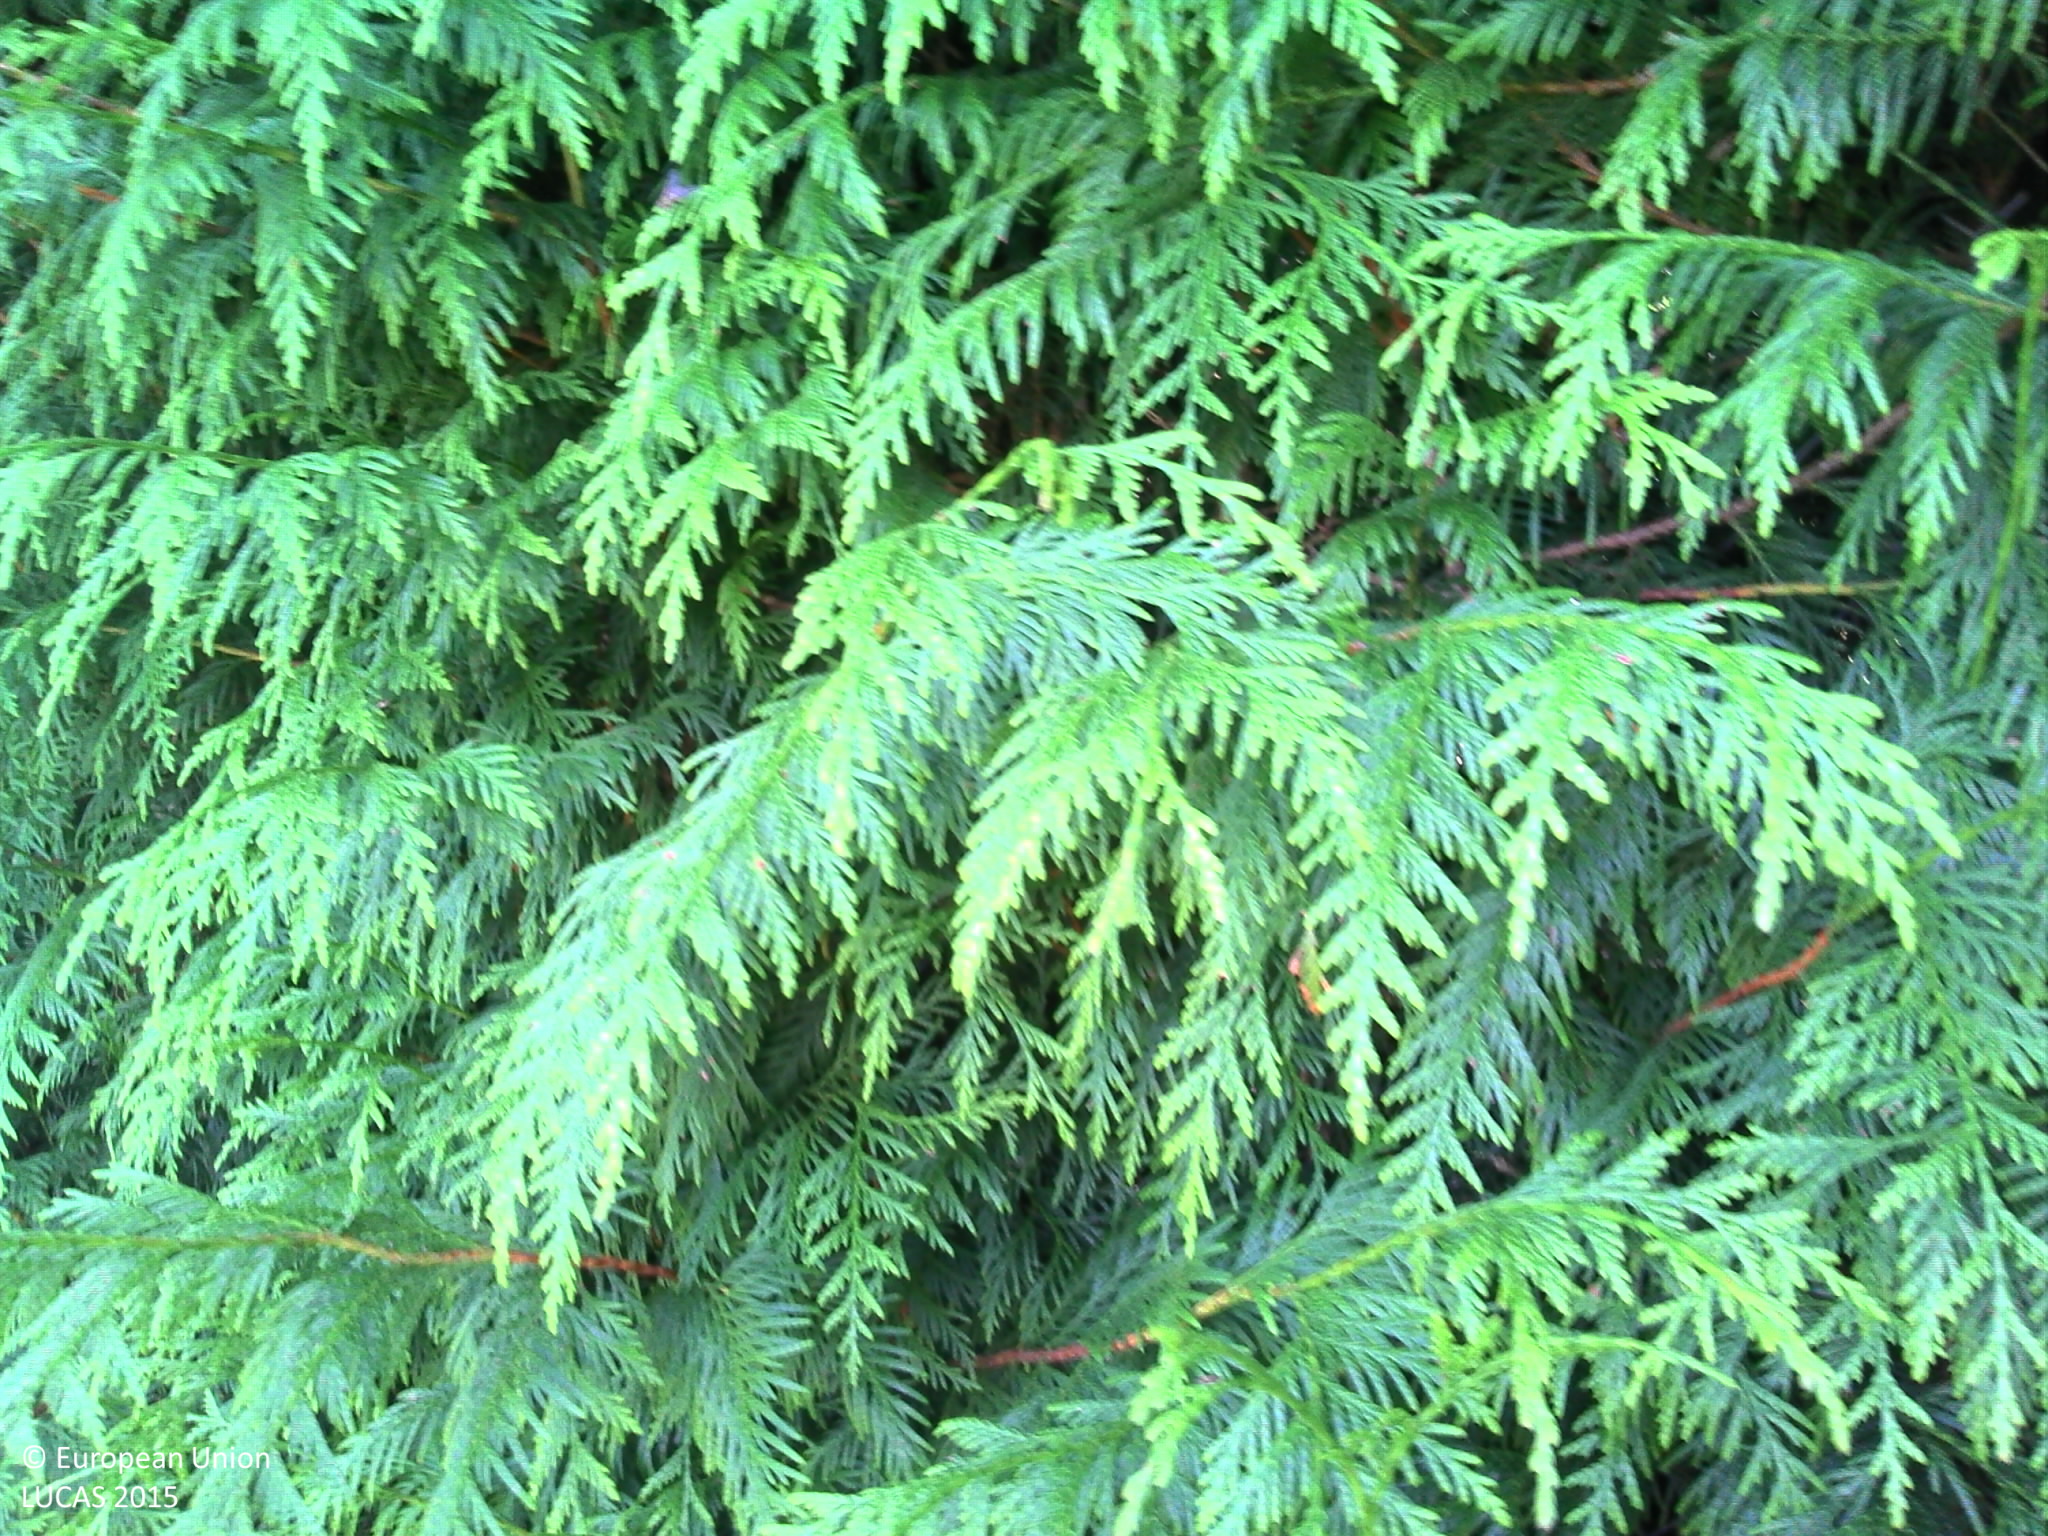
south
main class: Grassland
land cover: Grassland without tree/shrub cover
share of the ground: > 75 %
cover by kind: herbaceous plants 100 %
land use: Agriculture (excluding fallow land and kitchen gardens)
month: August
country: FR
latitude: 45.9331
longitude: 1.4149
